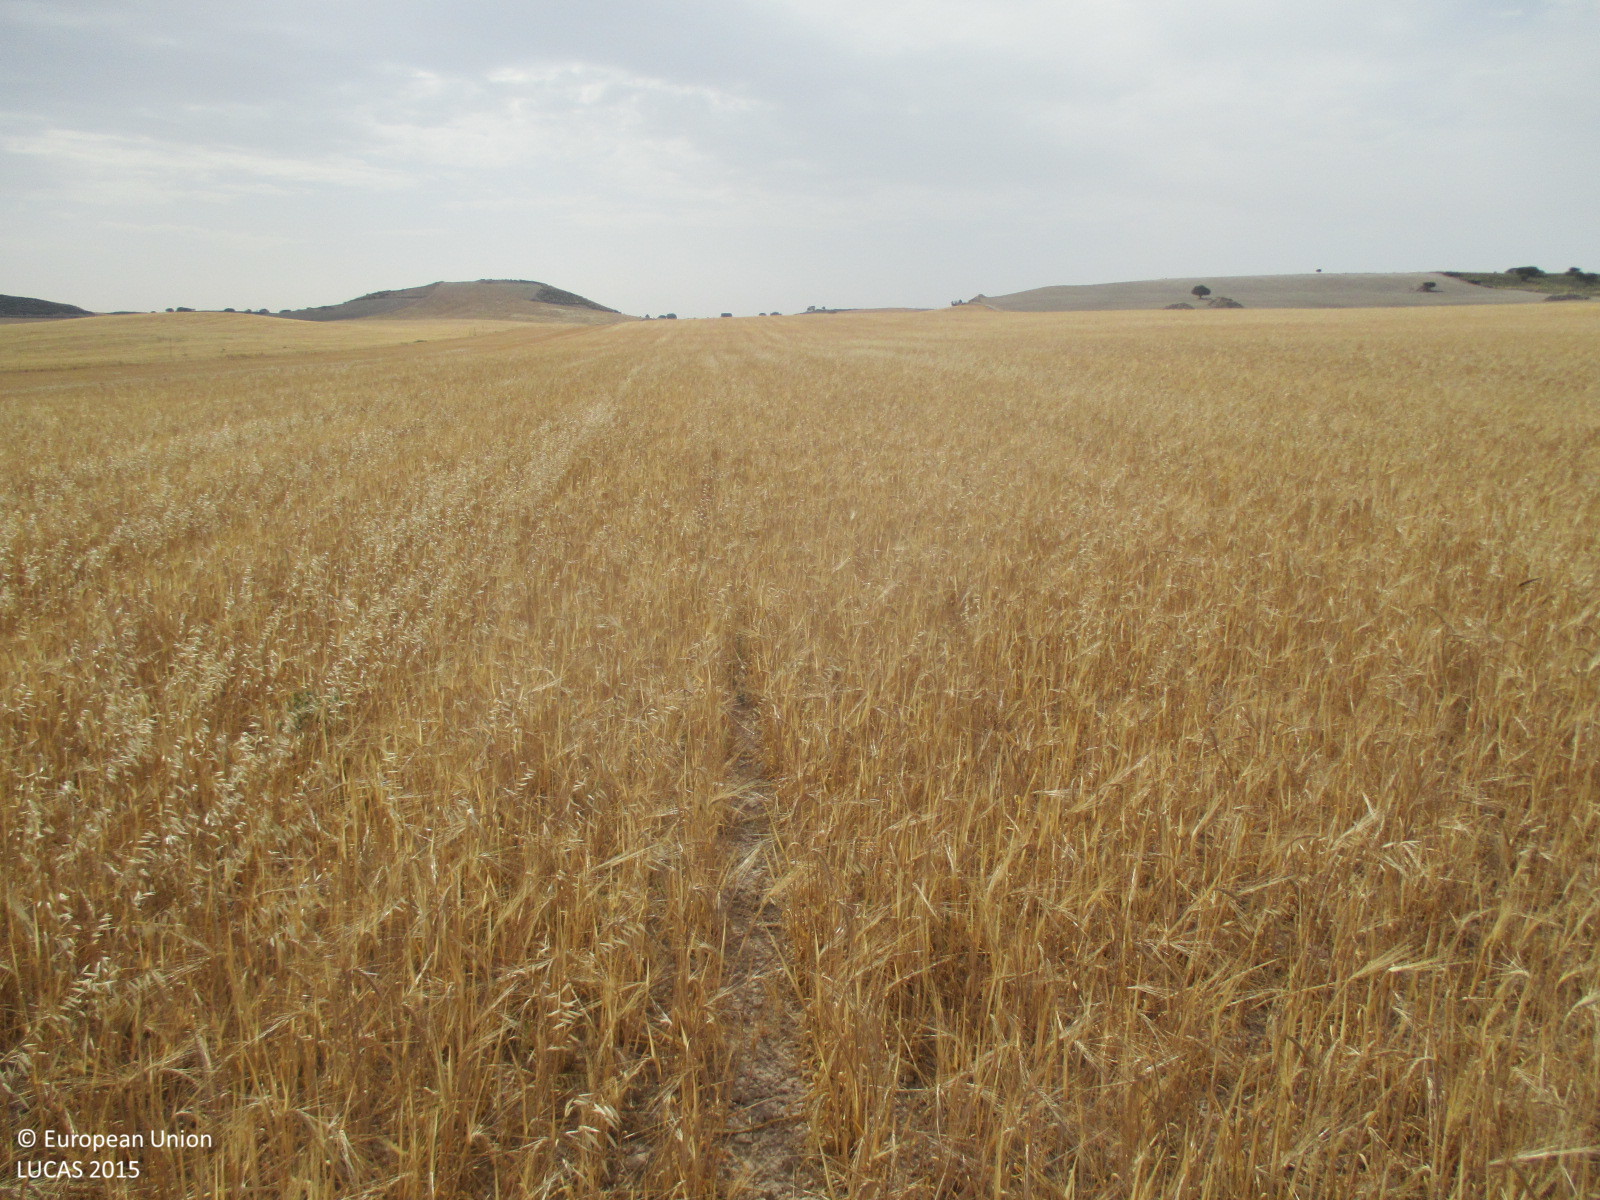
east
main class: Cropland
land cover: Barley
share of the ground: 50 - 75 %
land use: Agriculture (excluding fallow land and kitchen gardens)
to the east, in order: Barley; Grass margins; Barley
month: July
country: ES
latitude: 37.7936
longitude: -2.4010
